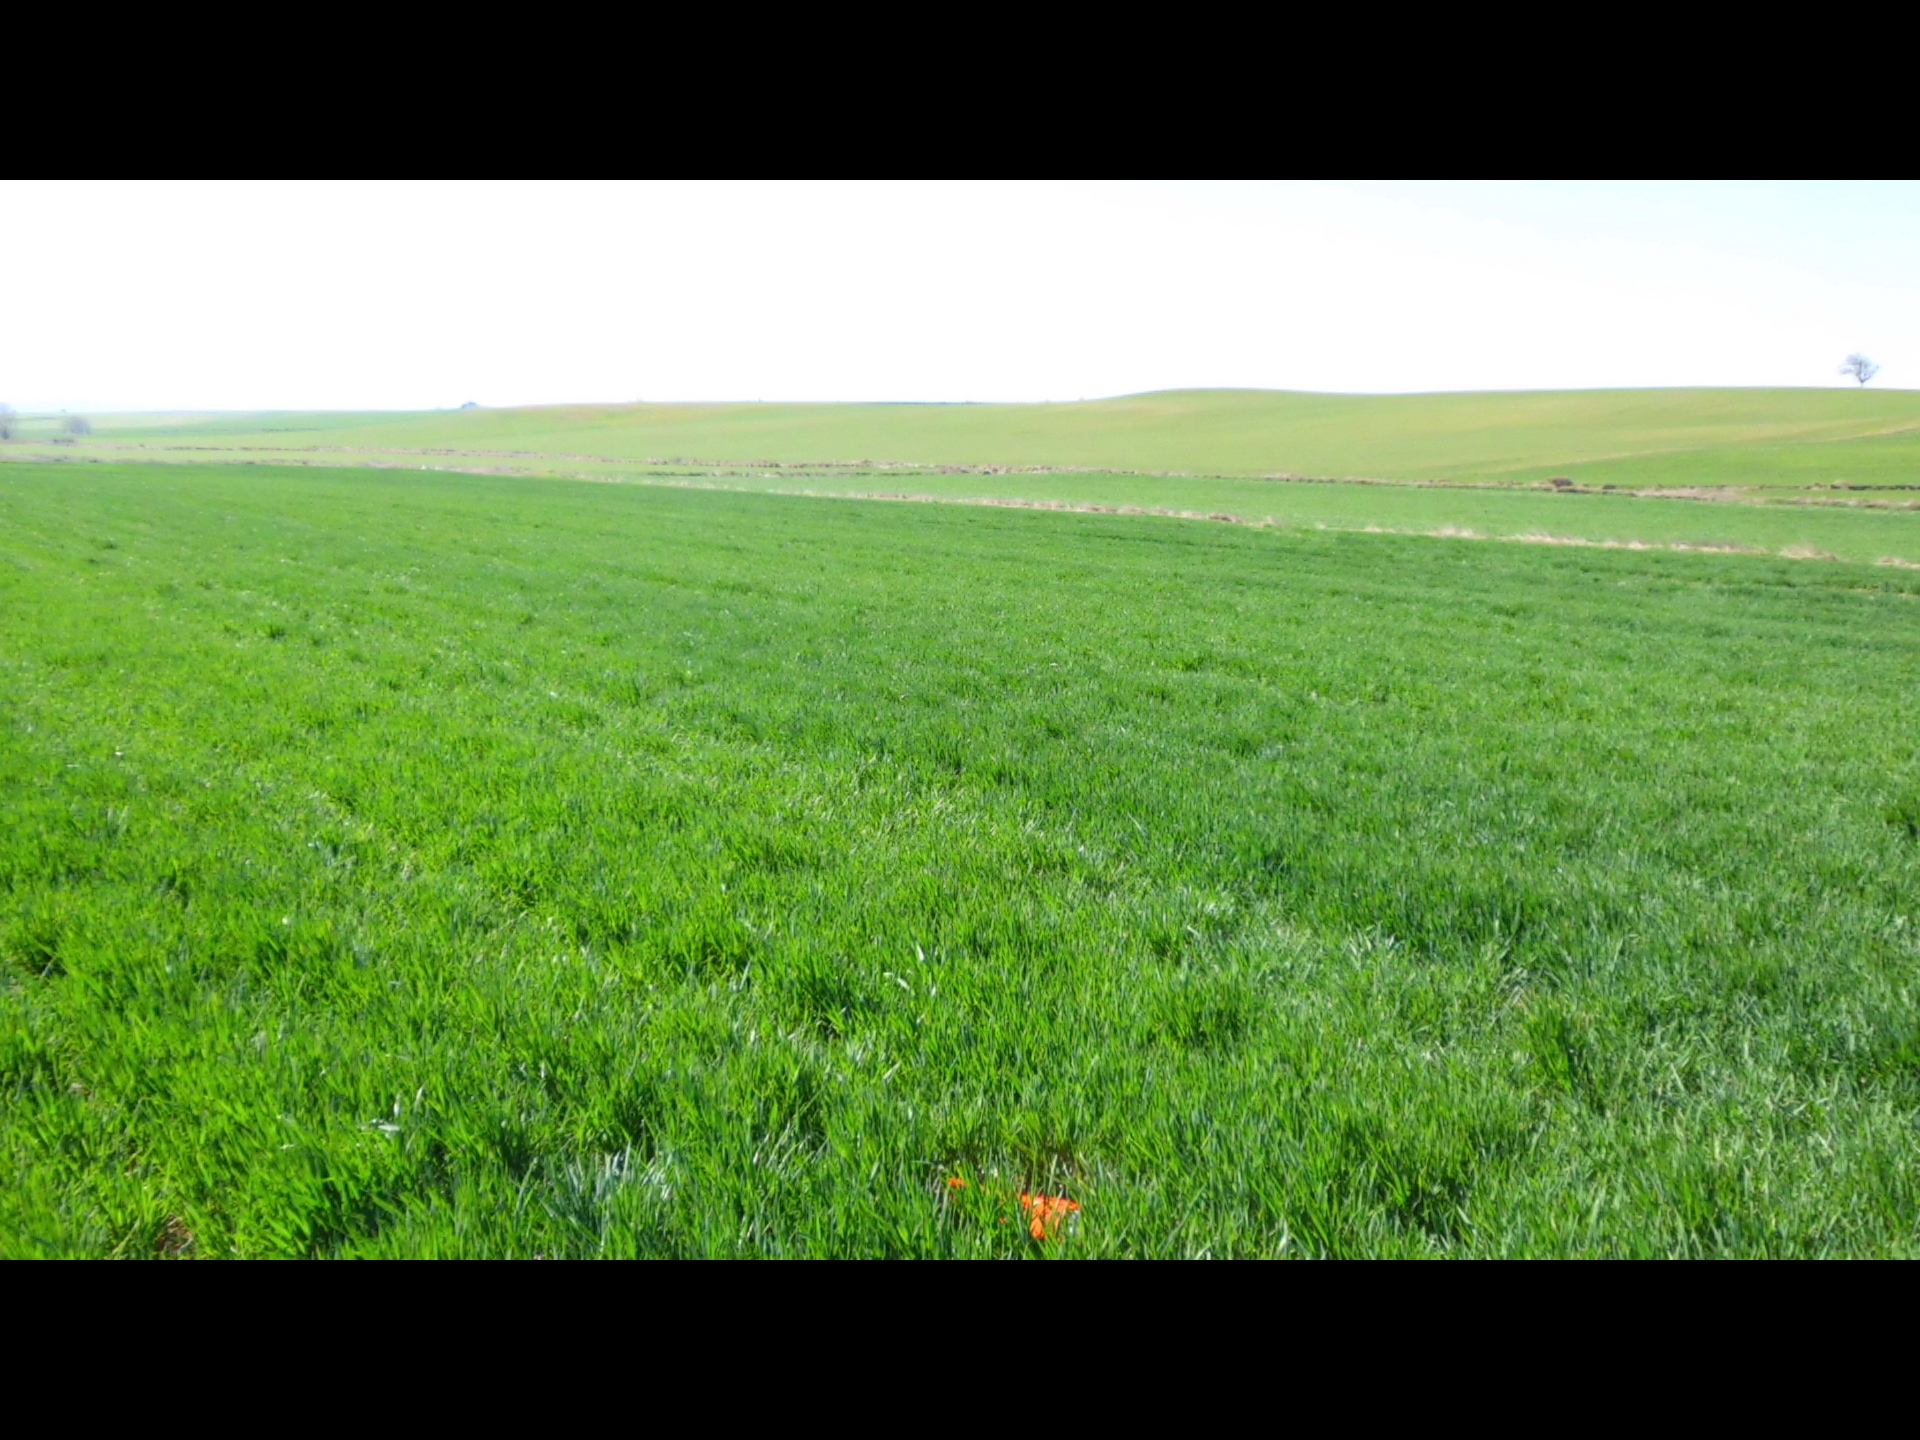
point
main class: Cropland
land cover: Common wheat
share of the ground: > 75 %
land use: Agriculture (excluding fallow land and kitchen gardens)
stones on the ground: < 10 %
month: April
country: ES
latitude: 42.2251
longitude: -3.7383
